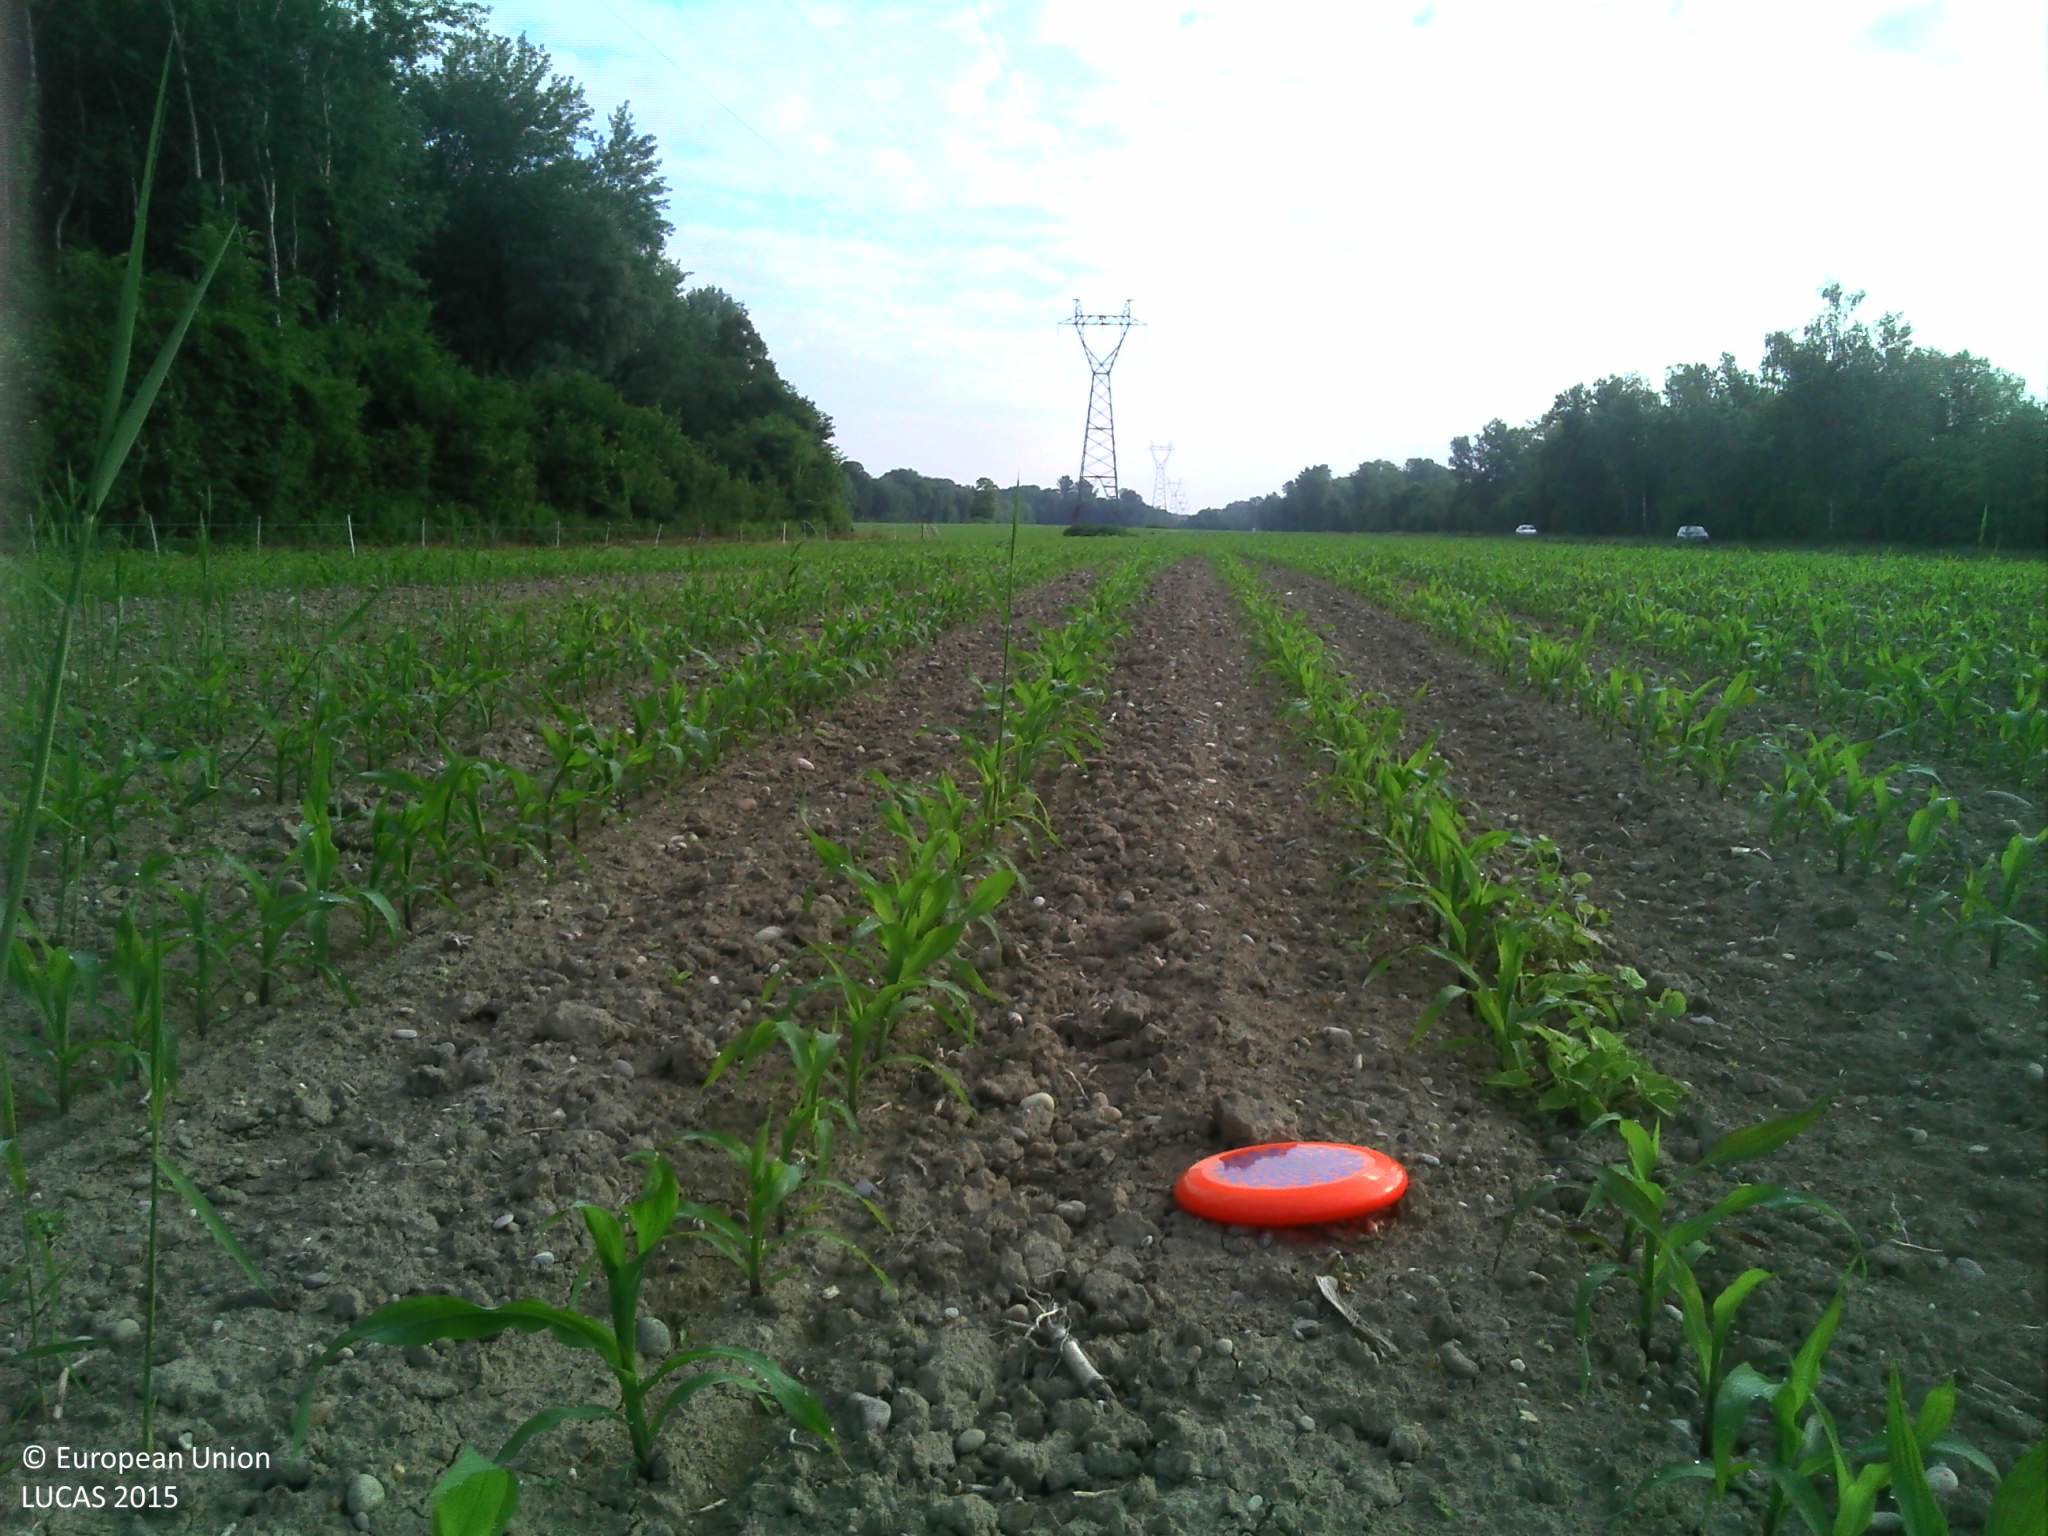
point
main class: Cropland
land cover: Maize
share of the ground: 10 - 25 %
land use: Agriculture (excluding fallow land and kitchen gardens)
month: May
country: FR
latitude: 48.1247
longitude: 7.5694
